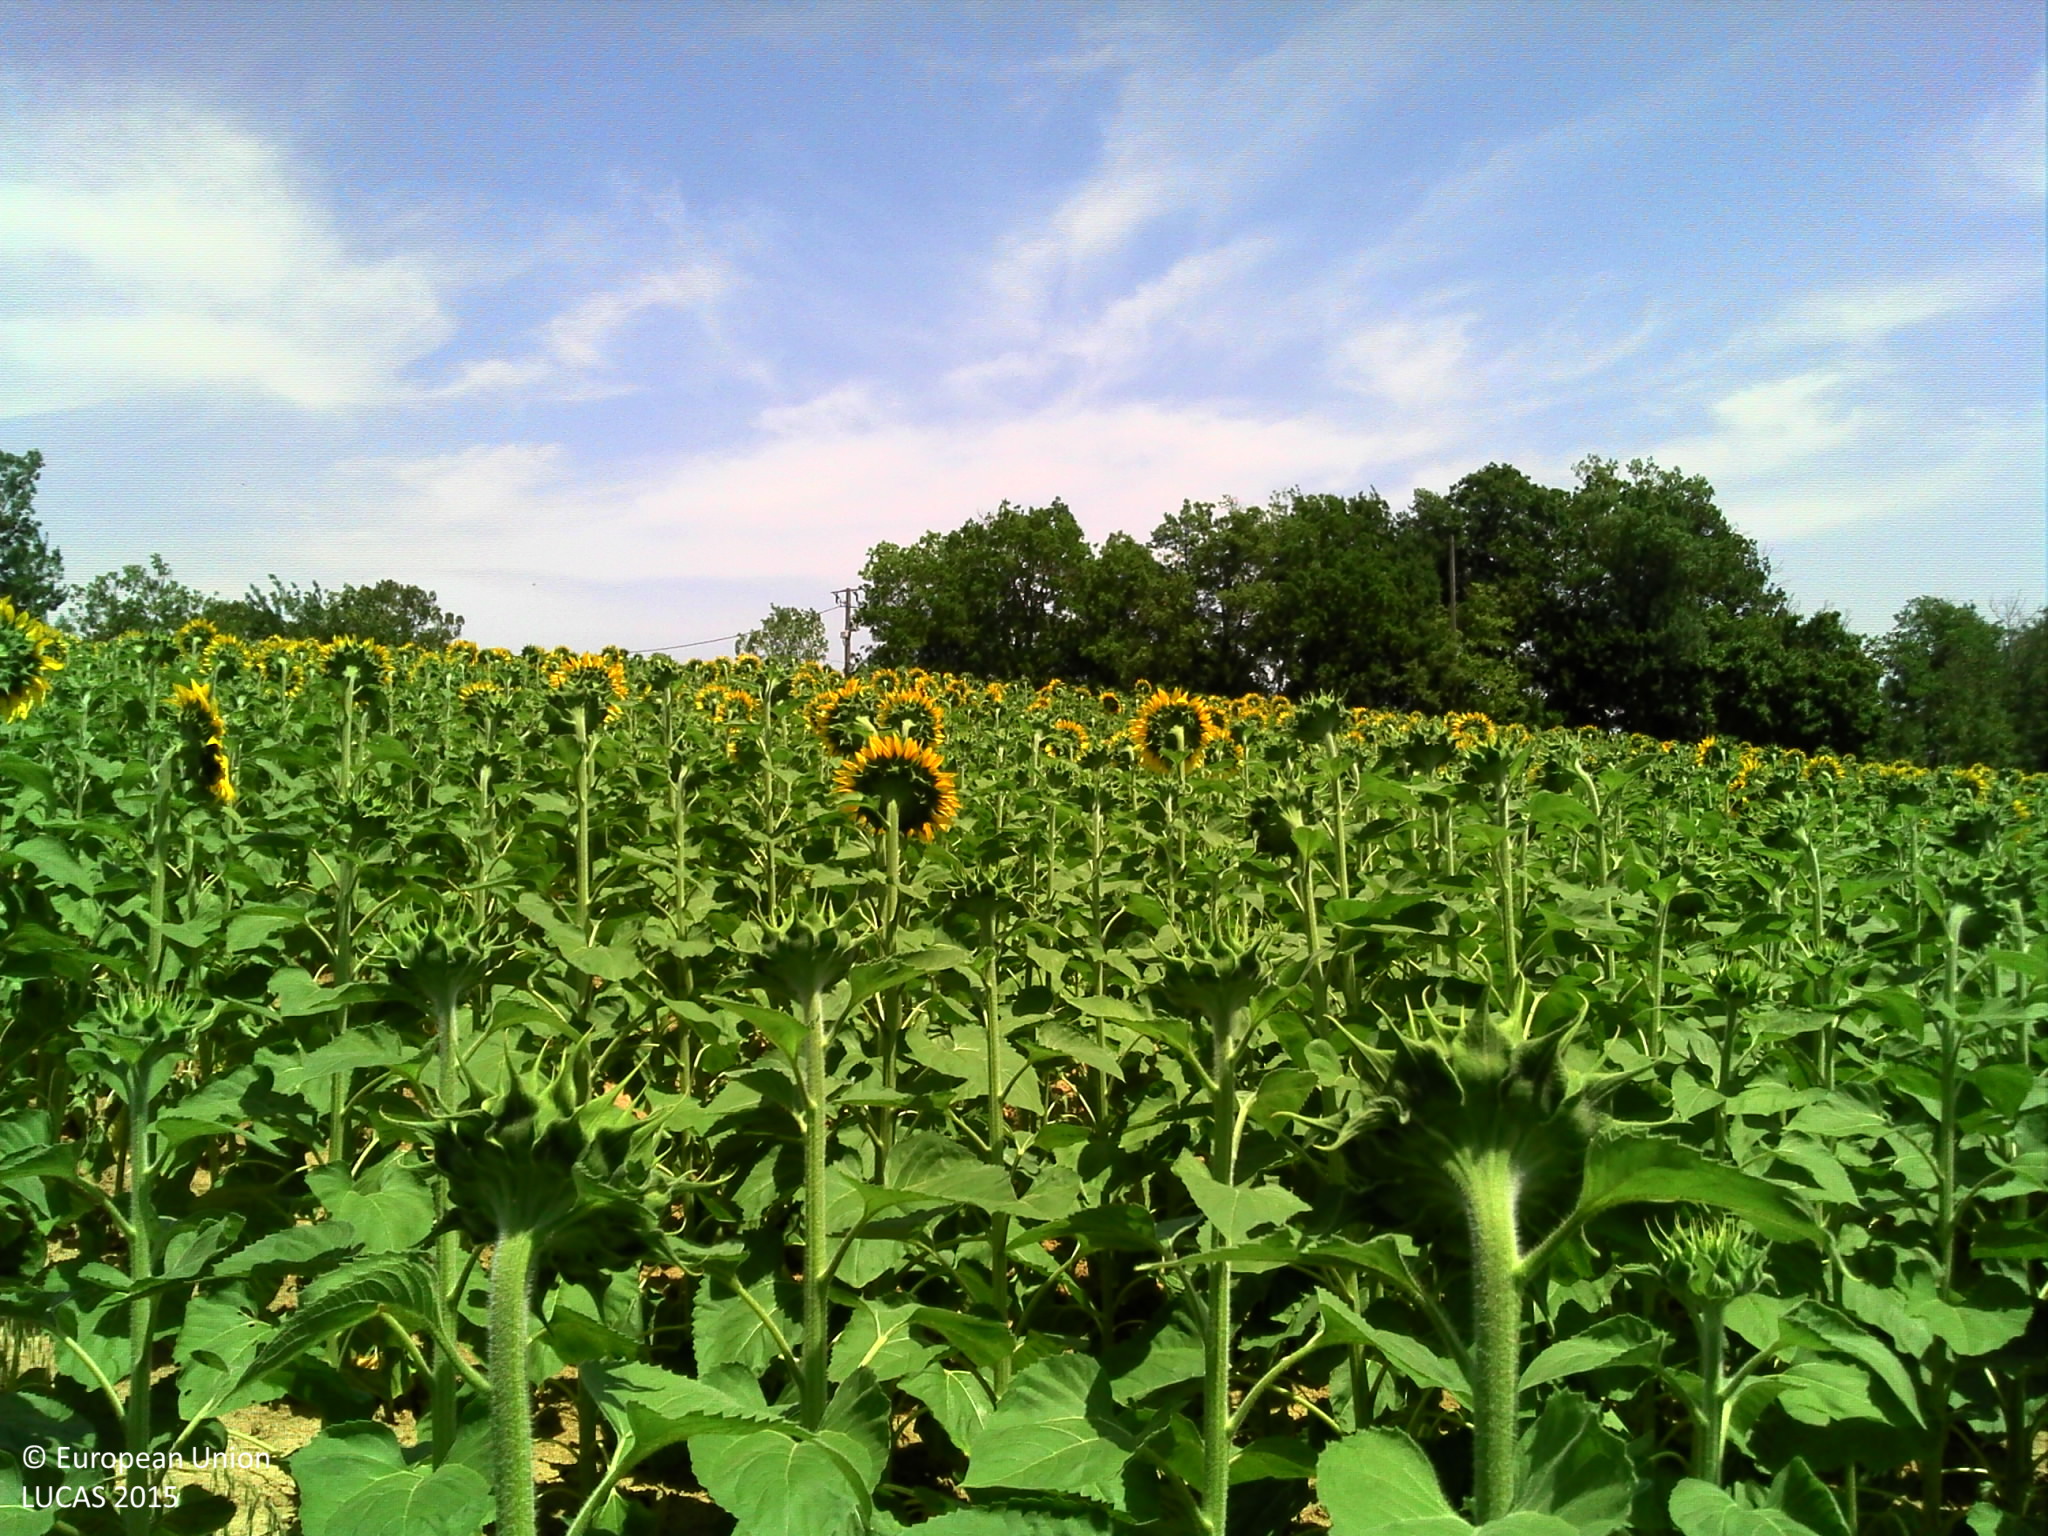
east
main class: Cropland
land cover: Sunflower
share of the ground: > 75 %
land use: Agriculture (excluding fallow land and kitchen gardens)
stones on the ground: < 10 %
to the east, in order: Sunflower; Broadleaved woodland; Grass margins; Ditches and canals; Paved roads, cycling and walking lanes; Ditches and canals; Electric lines; Grass margins; Broadleaved woodland; Grassland without tree/shrub cover; Managed hedges; Electric lines; Grass margins; Ditches and canals; Paved roads, cycling and walking lanes; Grass margins; Electric lines; Managed hedges; Grassland without tree/shrub cover; Artificial constructions in urban areas; Grassland without tree/shrub cover; Conifer hedges; Durum wheat
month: July
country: FR
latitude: 43.4881
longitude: 1.0117
